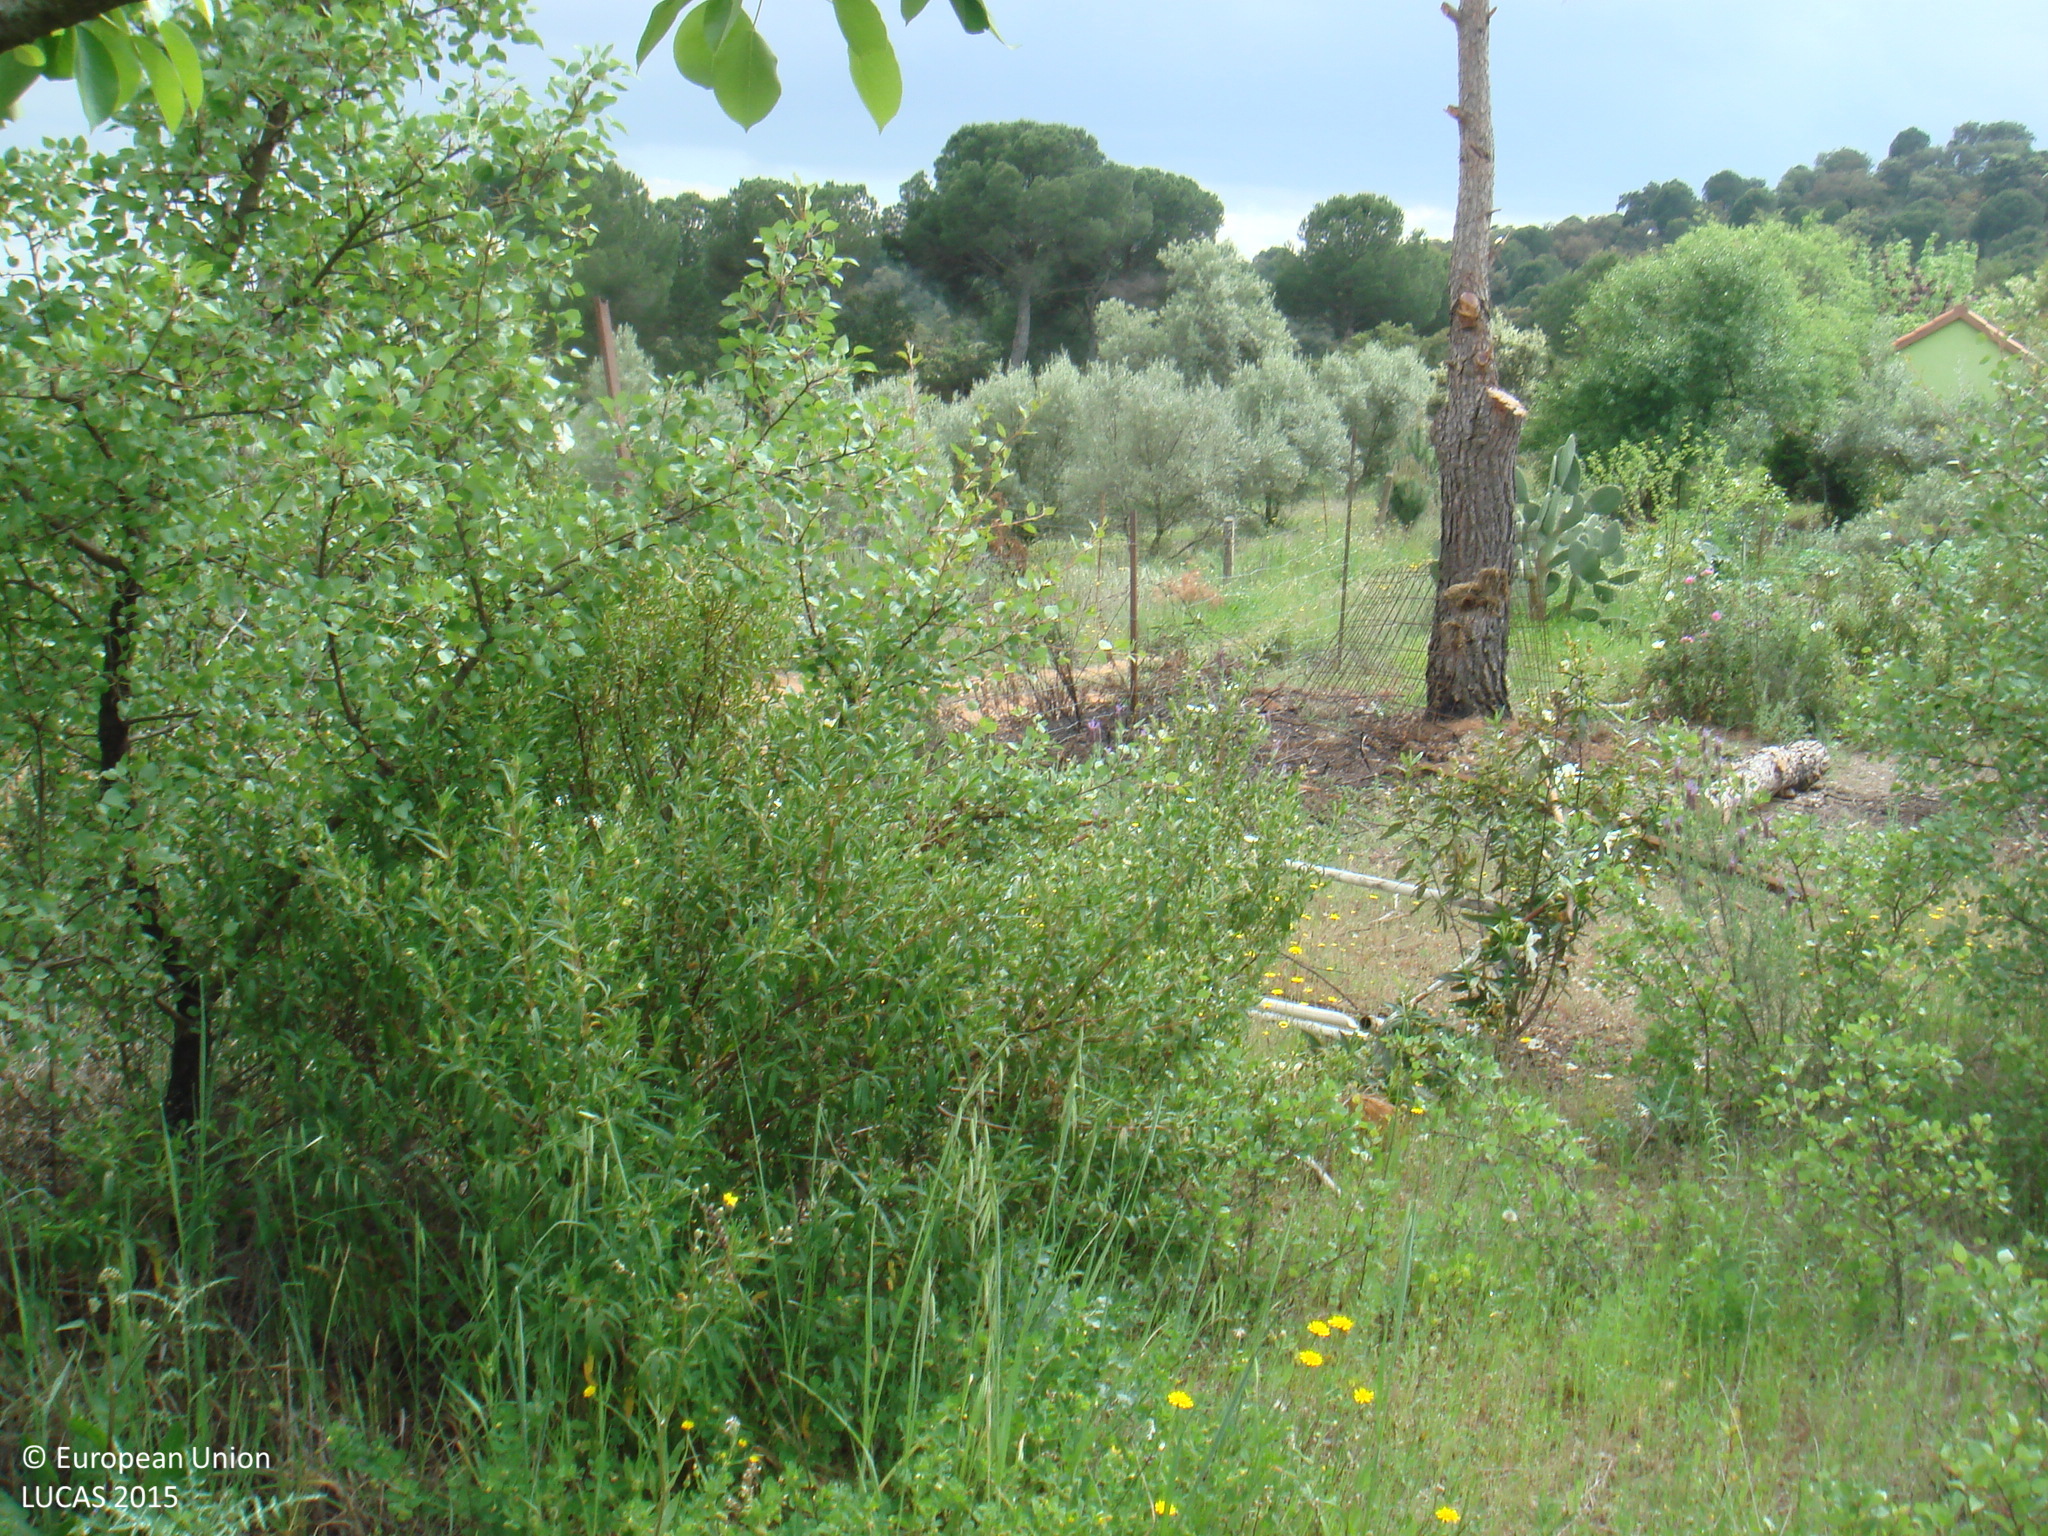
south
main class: Shrubland
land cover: Shrubland without tree cover
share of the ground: 50 - 75 %
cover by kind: shrubs 50 %, herbaceous plants 40 %, unconsolidated bare surface 10 %
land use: Semi-natural and natural areas not in use
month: April
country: ES
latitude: 38.0225
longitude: -4.9995
